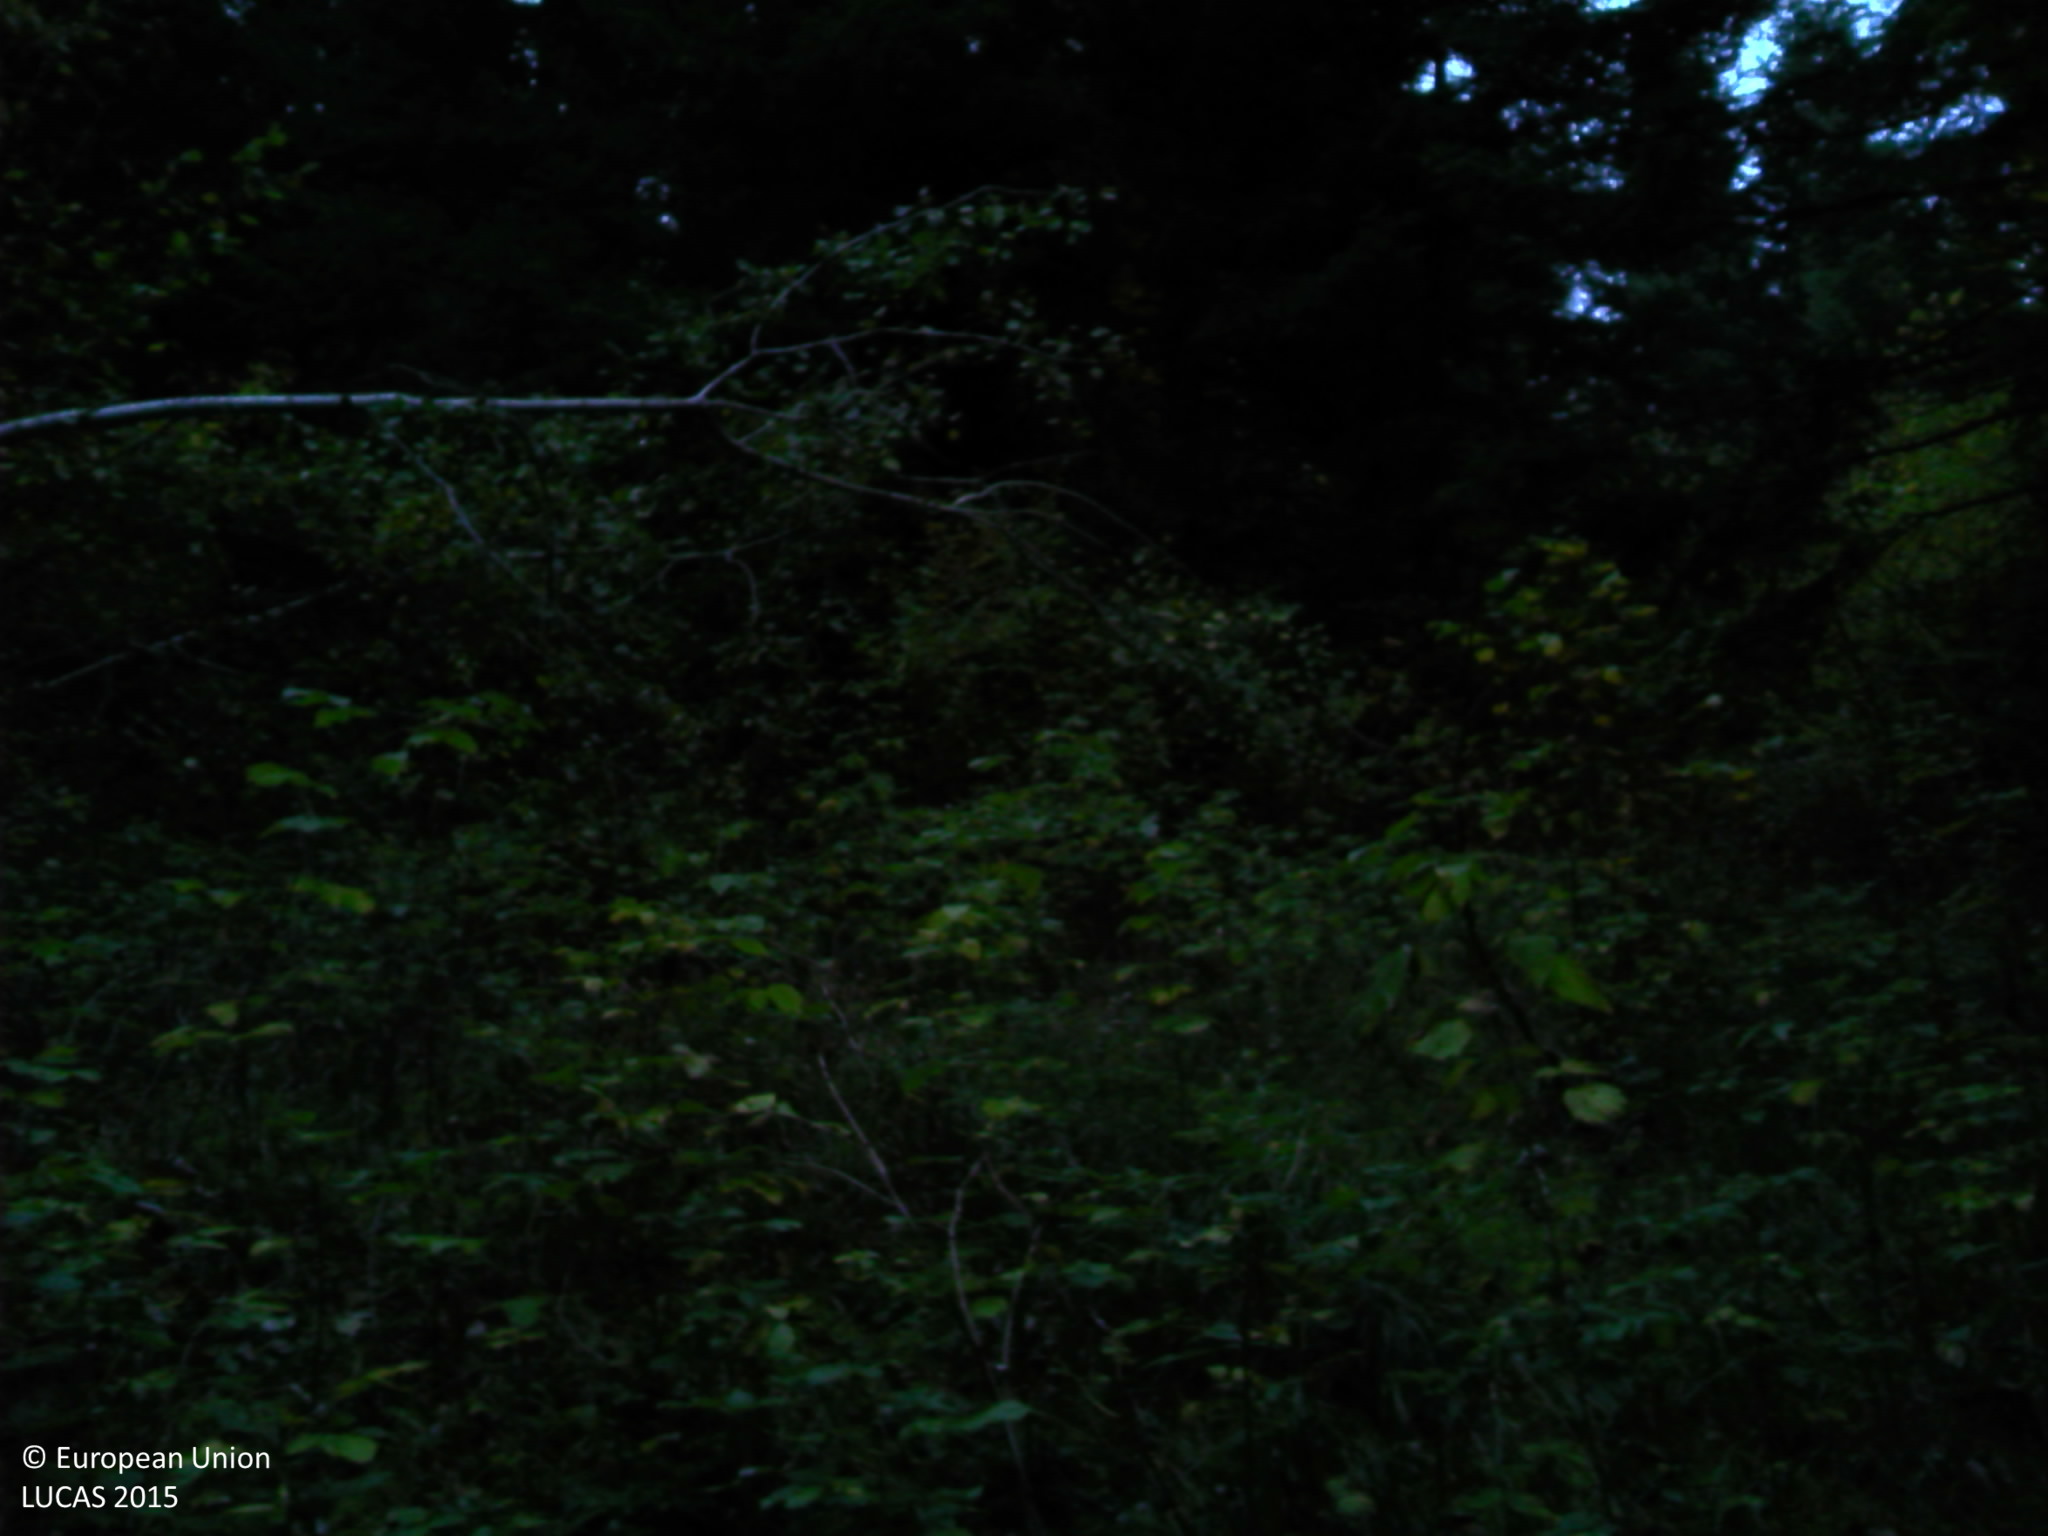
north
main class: Woodland
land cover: Spruce dominated mixed woodland
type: mountainous beech forest
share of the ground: > 75 %
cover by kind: coniferous forest trees 40 %, broadleaved forest trees 40 %, shrubs 20 %
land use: Forestry
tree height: > 5 m
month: October
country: FR
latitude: 46.8583
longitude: 6.1330
